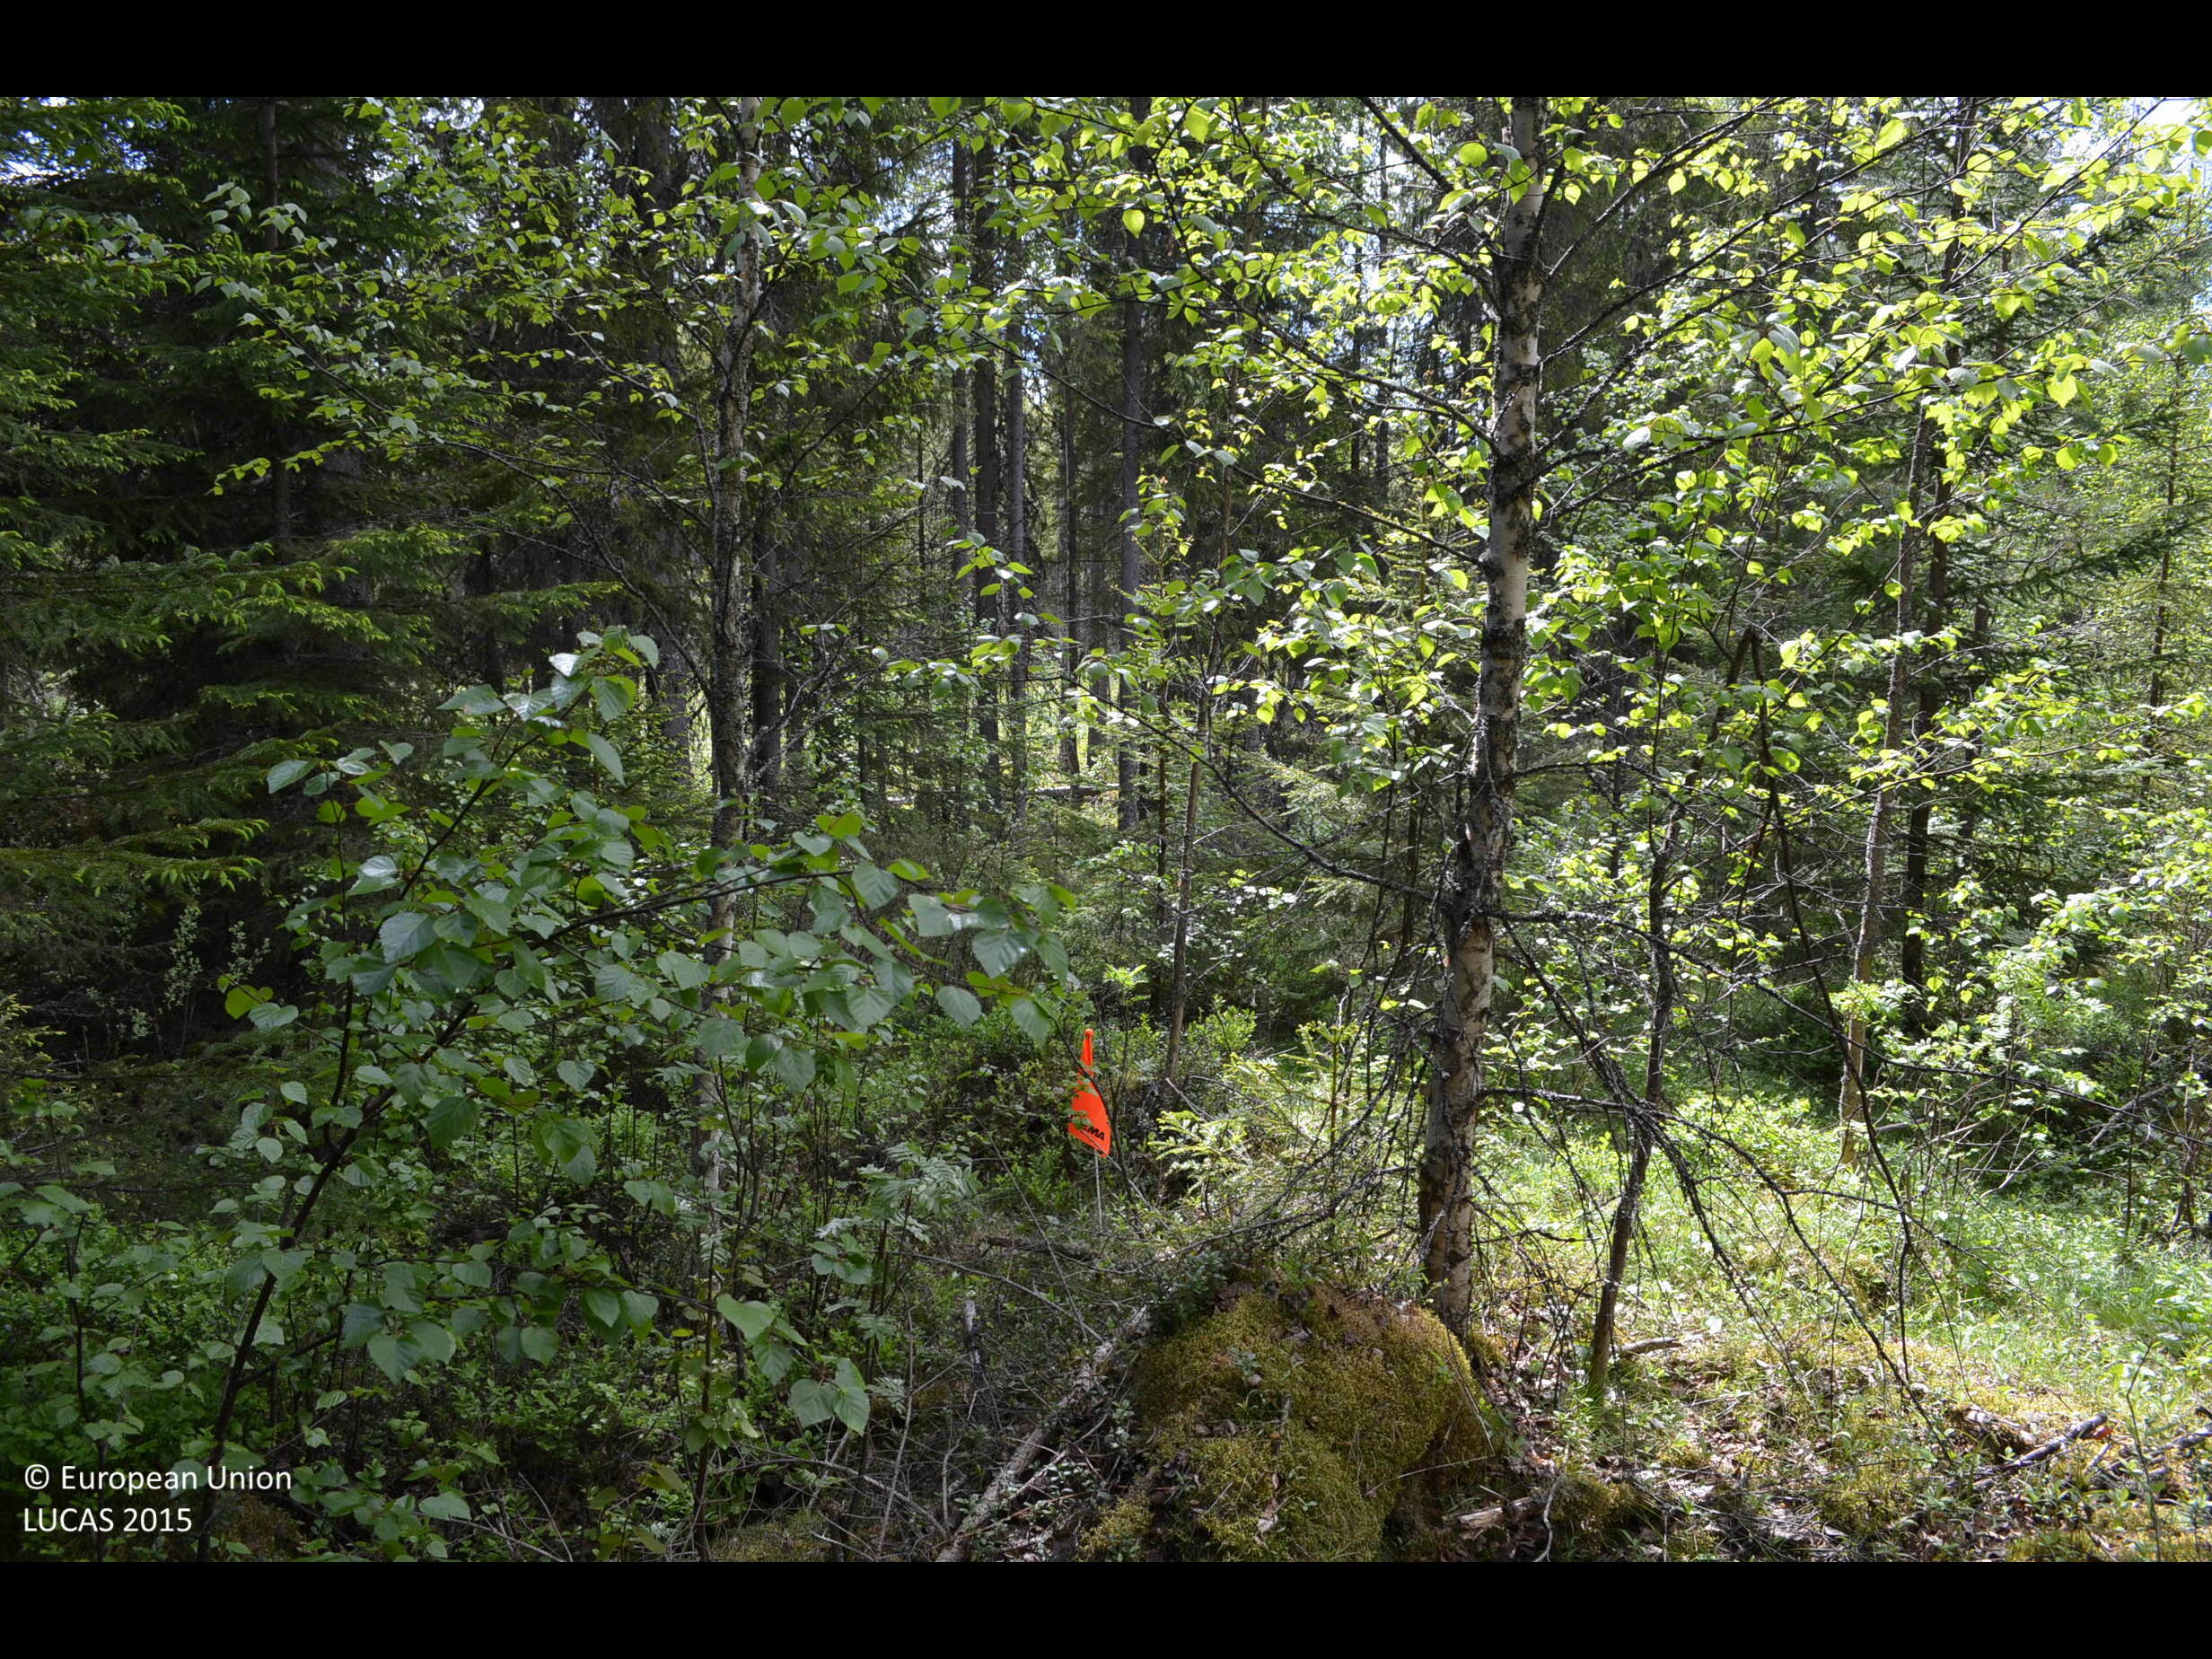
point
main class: Woodland
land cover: Other mixed woodland
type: boreal forest
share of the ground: > 75 %
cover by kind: coniferous forest trees 65 %, broadleaved forest trees 25 %, shrubs 5 %, herbaceous plants 5 %
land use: Forestry
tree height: > 5 m
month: June
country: FI
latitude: 61.8692
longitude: 23.1318
